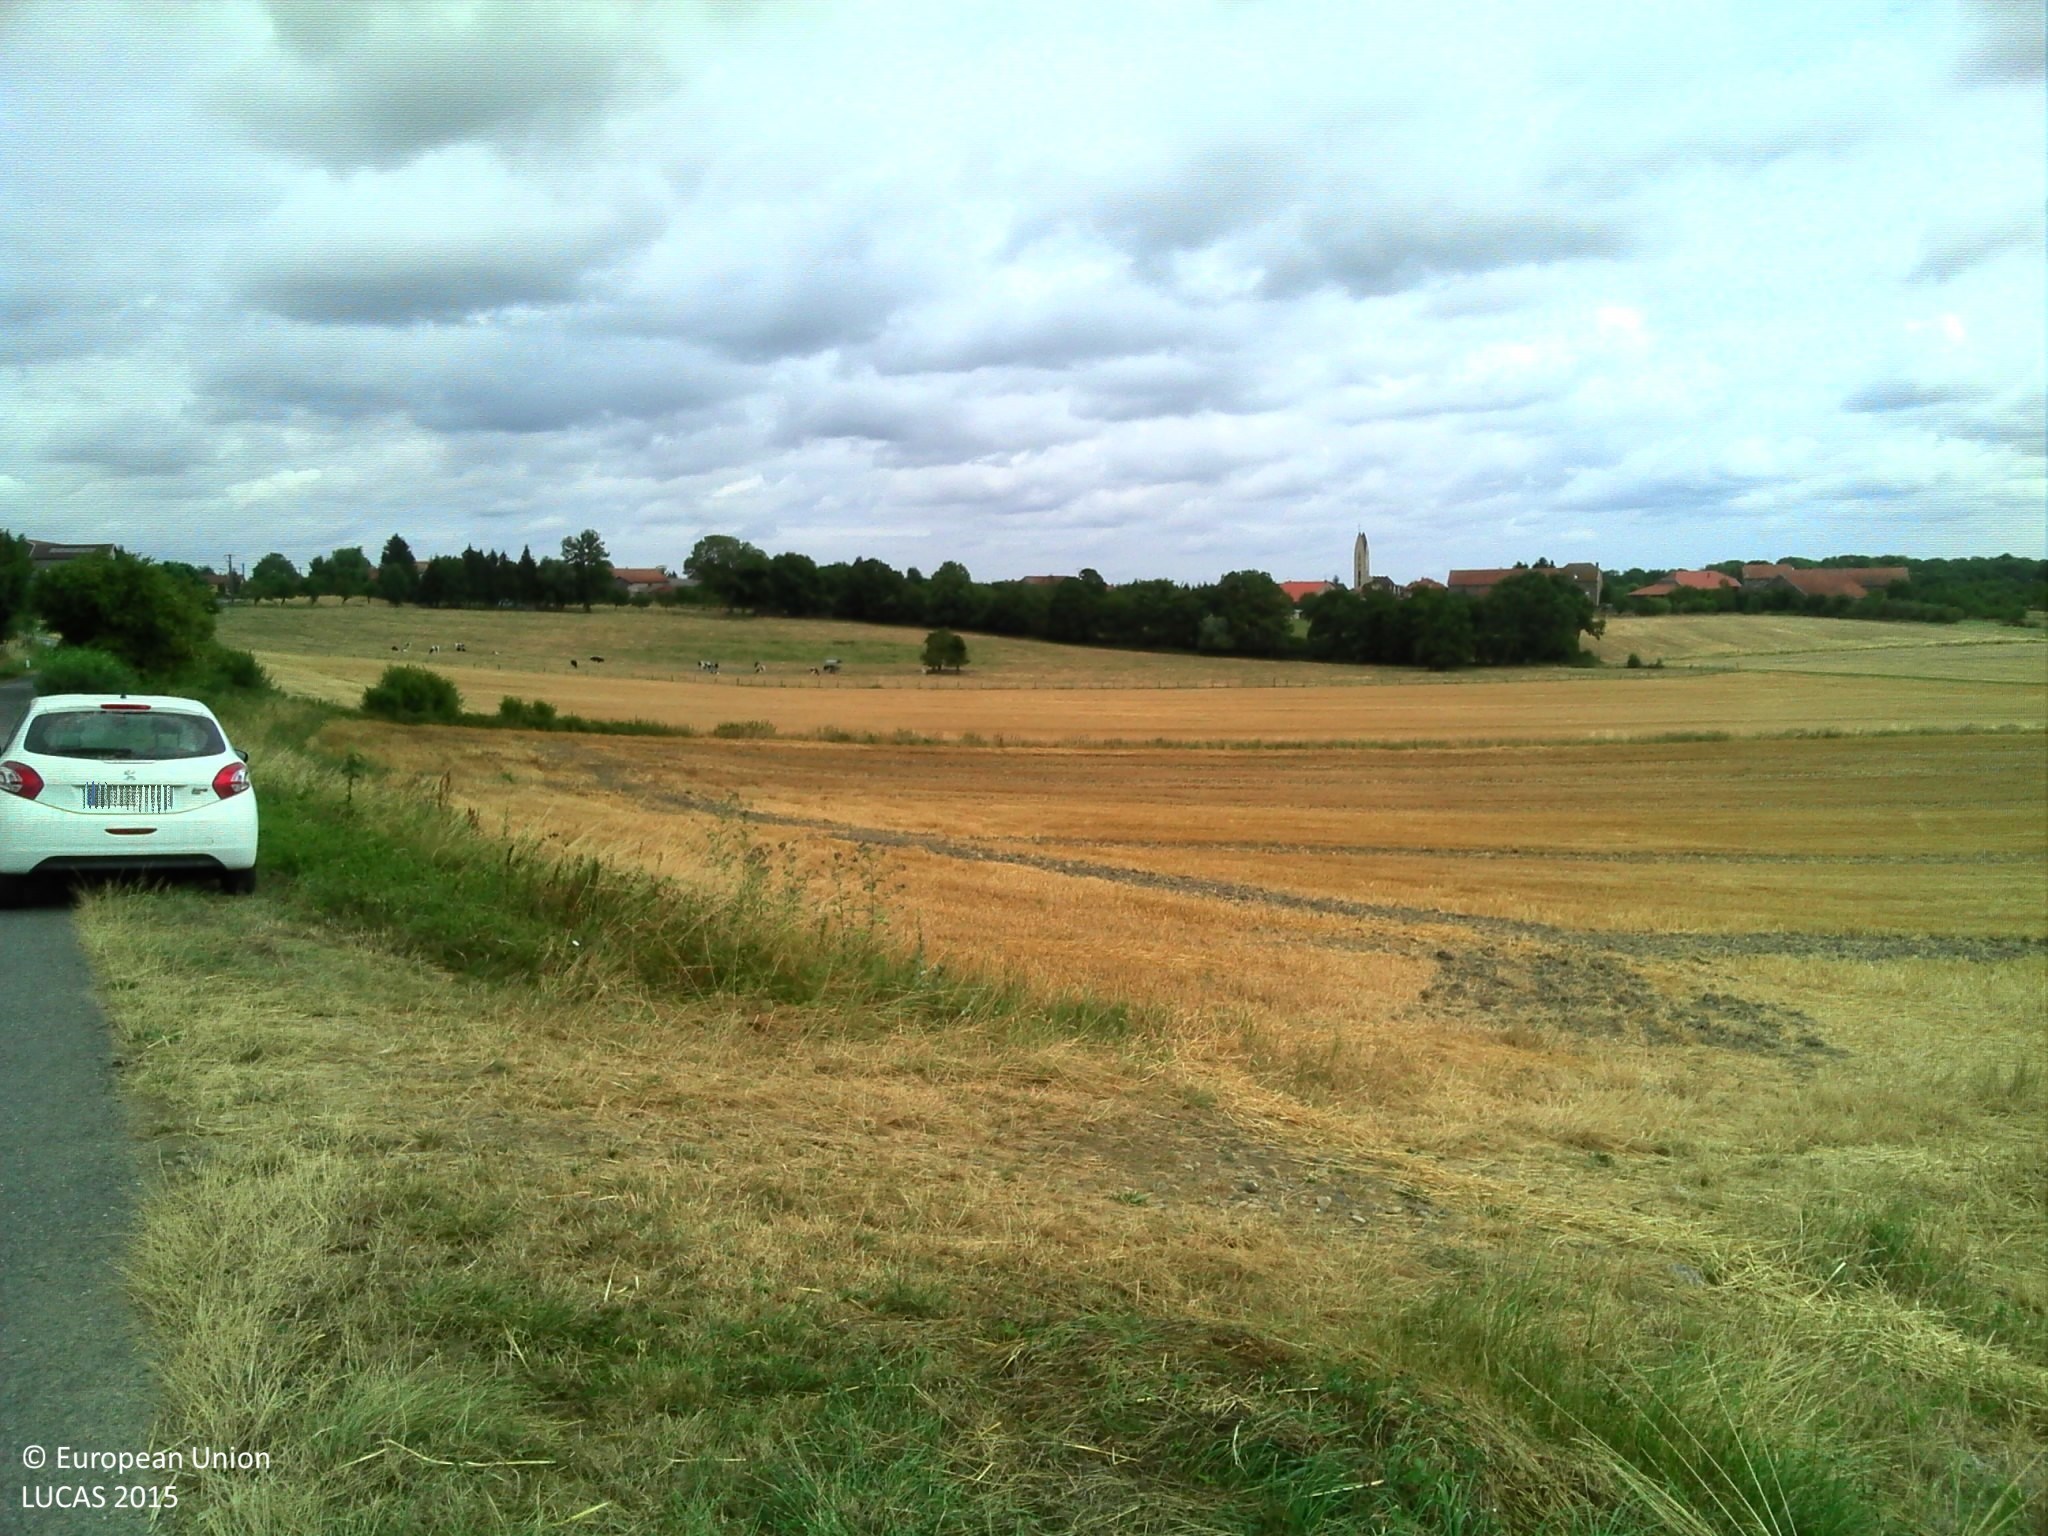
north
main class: Cropland
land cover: Common wheat
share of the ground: > 75 %
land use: Agriculture (excluding fallow land and kitchen gardens)
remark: Harvested field
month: July
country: FR
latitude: 48.6277
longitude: 6.8121
